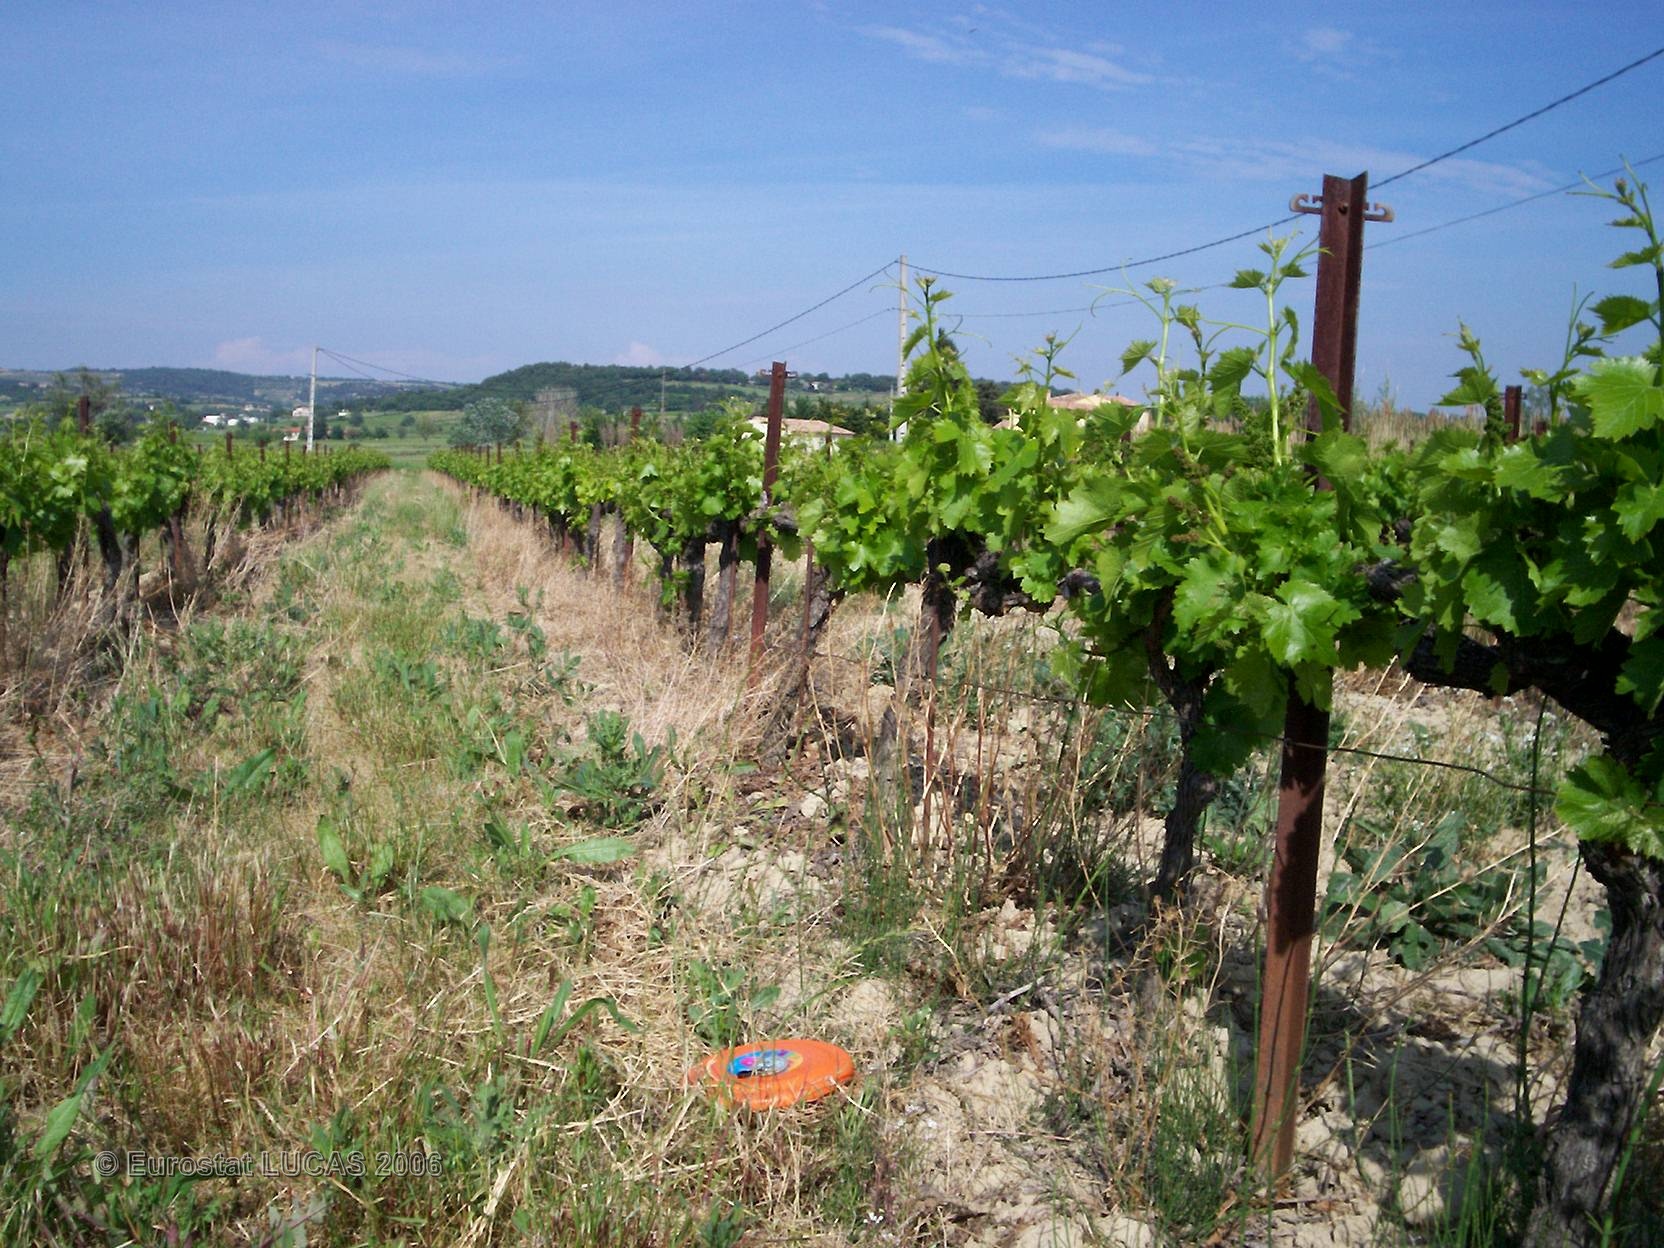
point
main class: Cropland
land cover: Vineyards
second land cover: Grassland with sparse tree/shrub cover
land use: Agriculture (excluding fallow land and kitchen gardens)
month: May
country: FR
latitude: 44.2990
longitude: 4.9313
